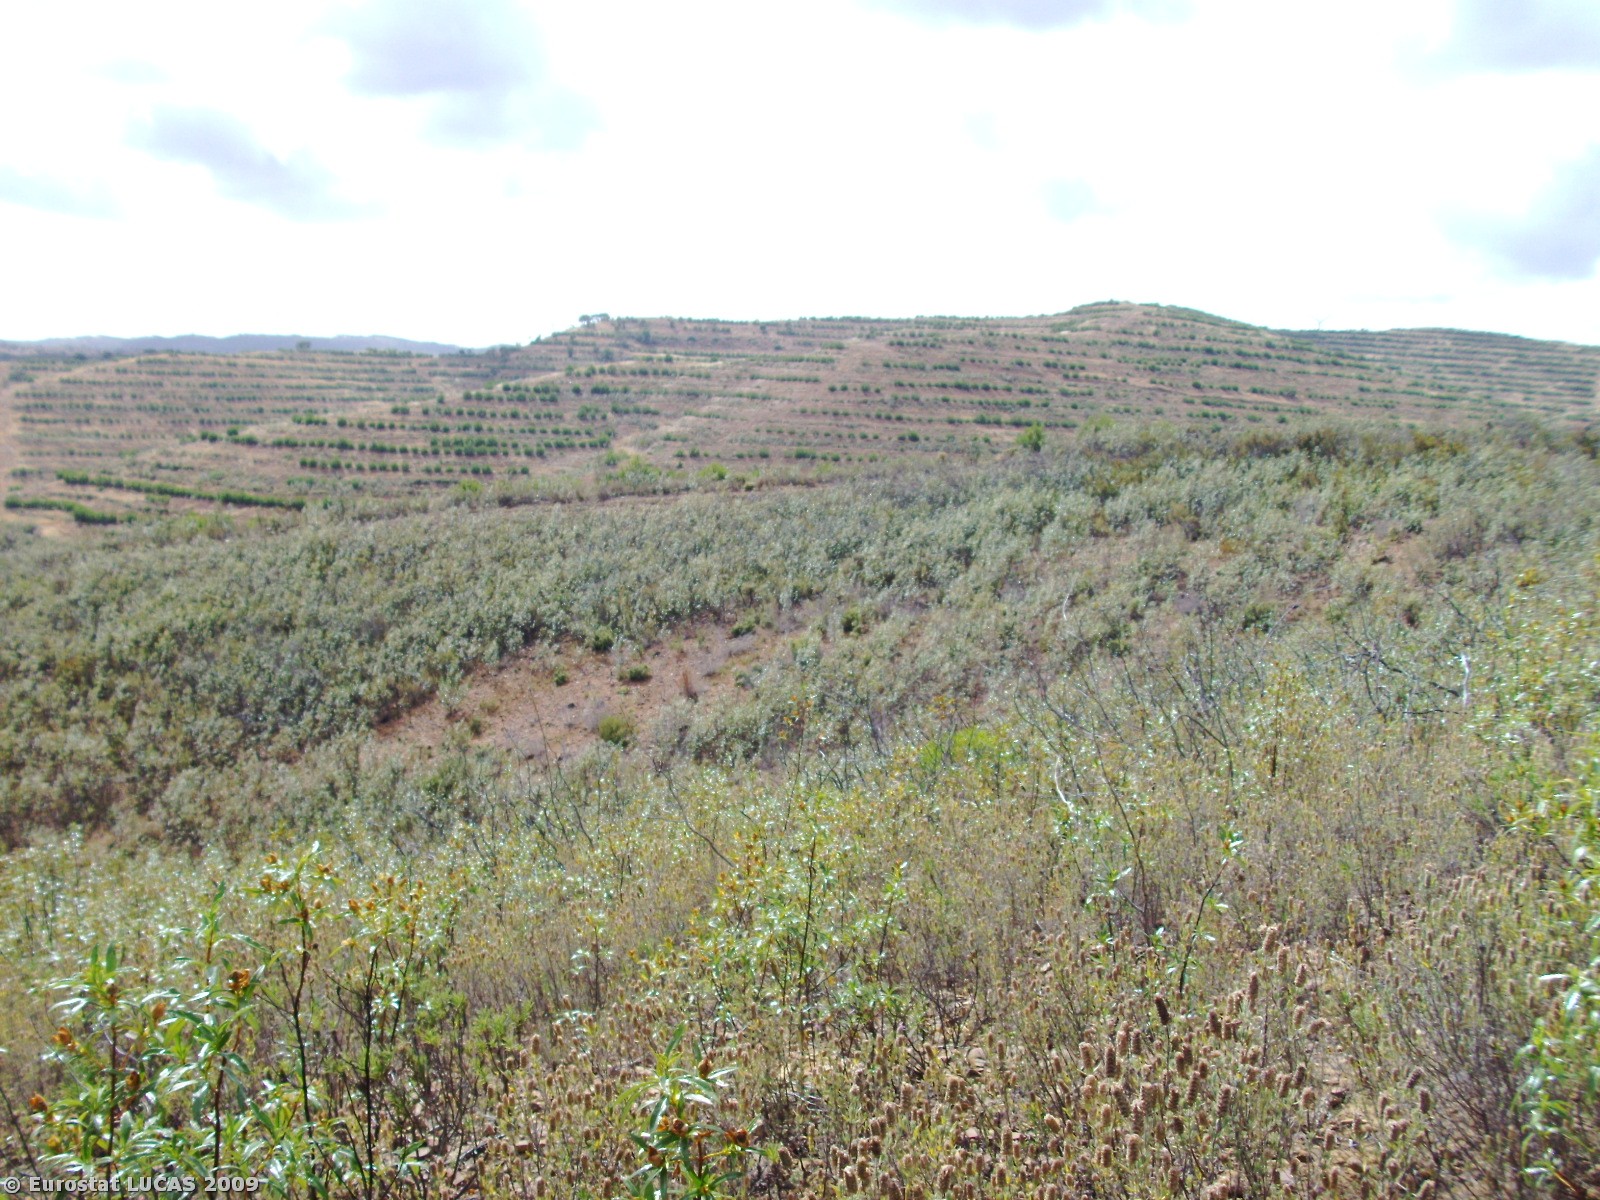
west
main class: Shrubland
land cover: Shrubland without tree cover
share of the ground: > 75 %
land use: Unused
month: June
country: PT
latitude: 37.2050
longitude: -8.7241
